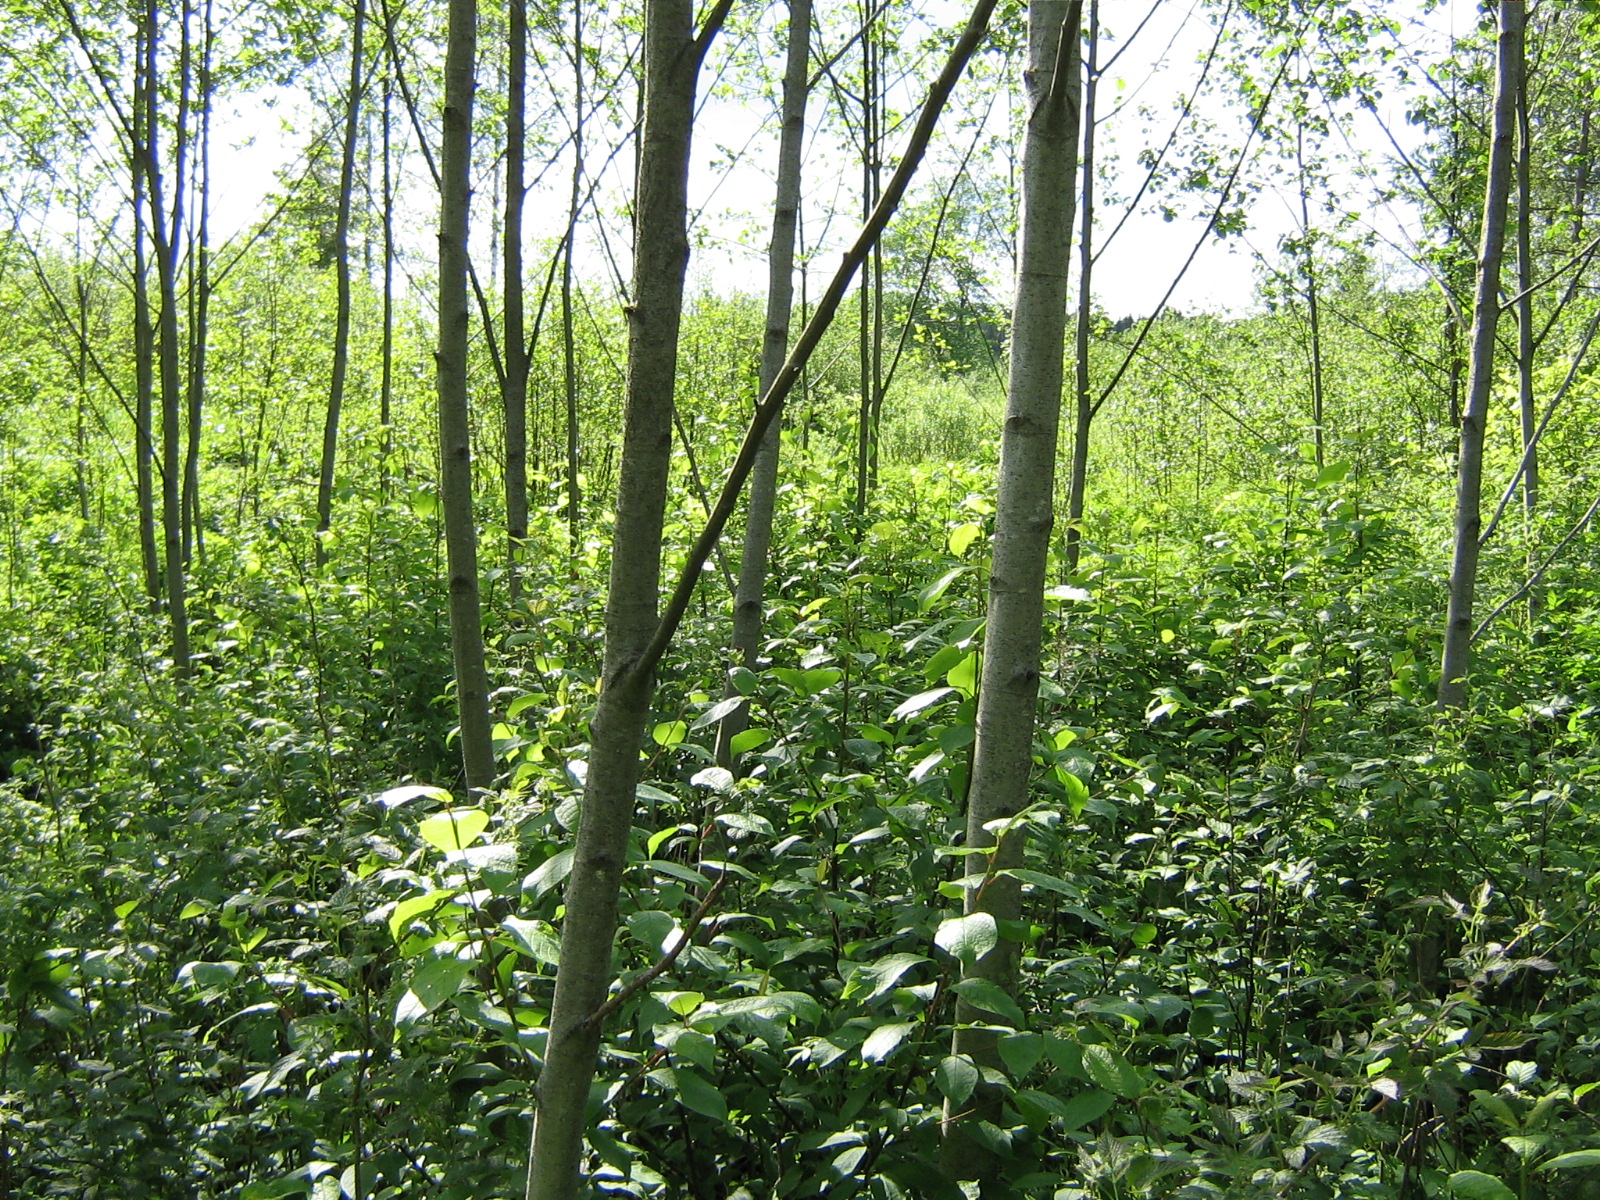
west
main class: Woodland
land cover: Broadleaved woodland
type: non-riverine alder, birch or aspen forest
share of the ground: > 75 %
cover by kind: broadleaved forest trees 100 %
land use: Forestry
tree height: < 5 m
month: June
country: LV
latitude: 57.0177
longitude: 25.3490
